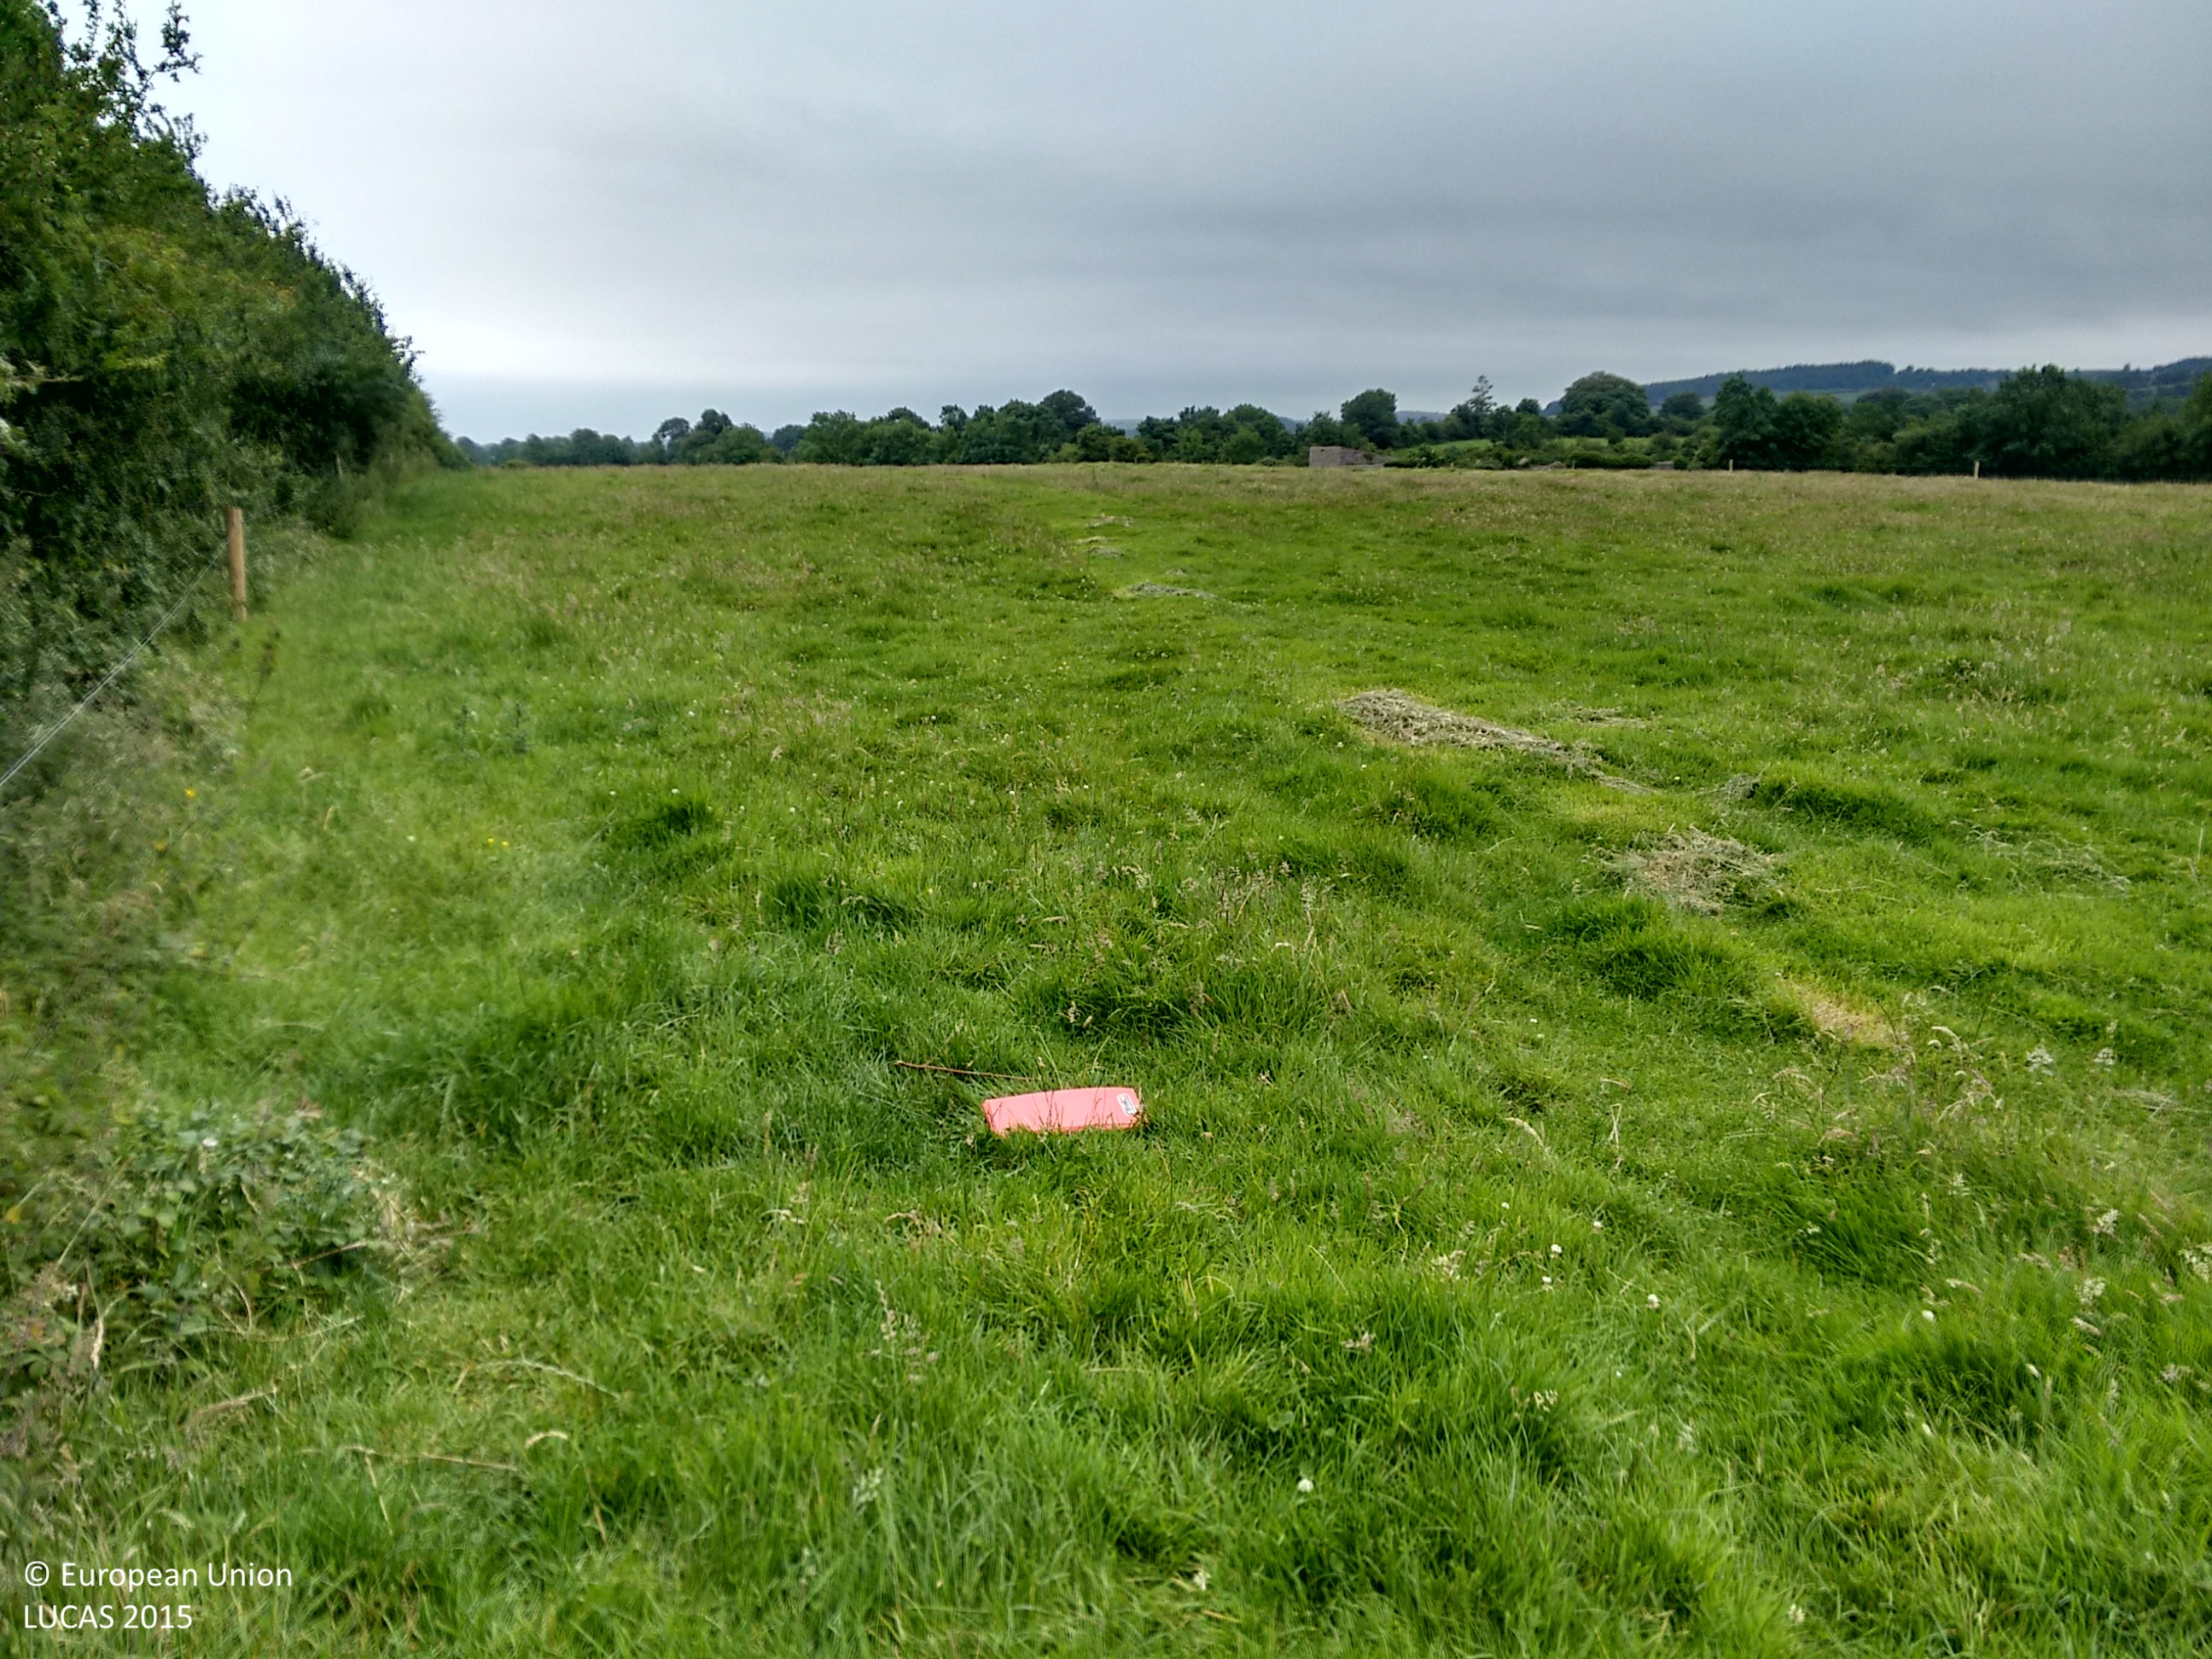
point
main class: Grassland
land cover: Grassland without tree/shrub cover
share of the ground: > 75 %
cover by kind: herbaceous plants 95 %, unconsolidated bare surface 5 %
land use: Agriculture (excluding fallow land and kitchen gardens)
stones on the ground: < 10 %
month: July
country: IE
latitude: 52.6780
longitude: -7.5392
